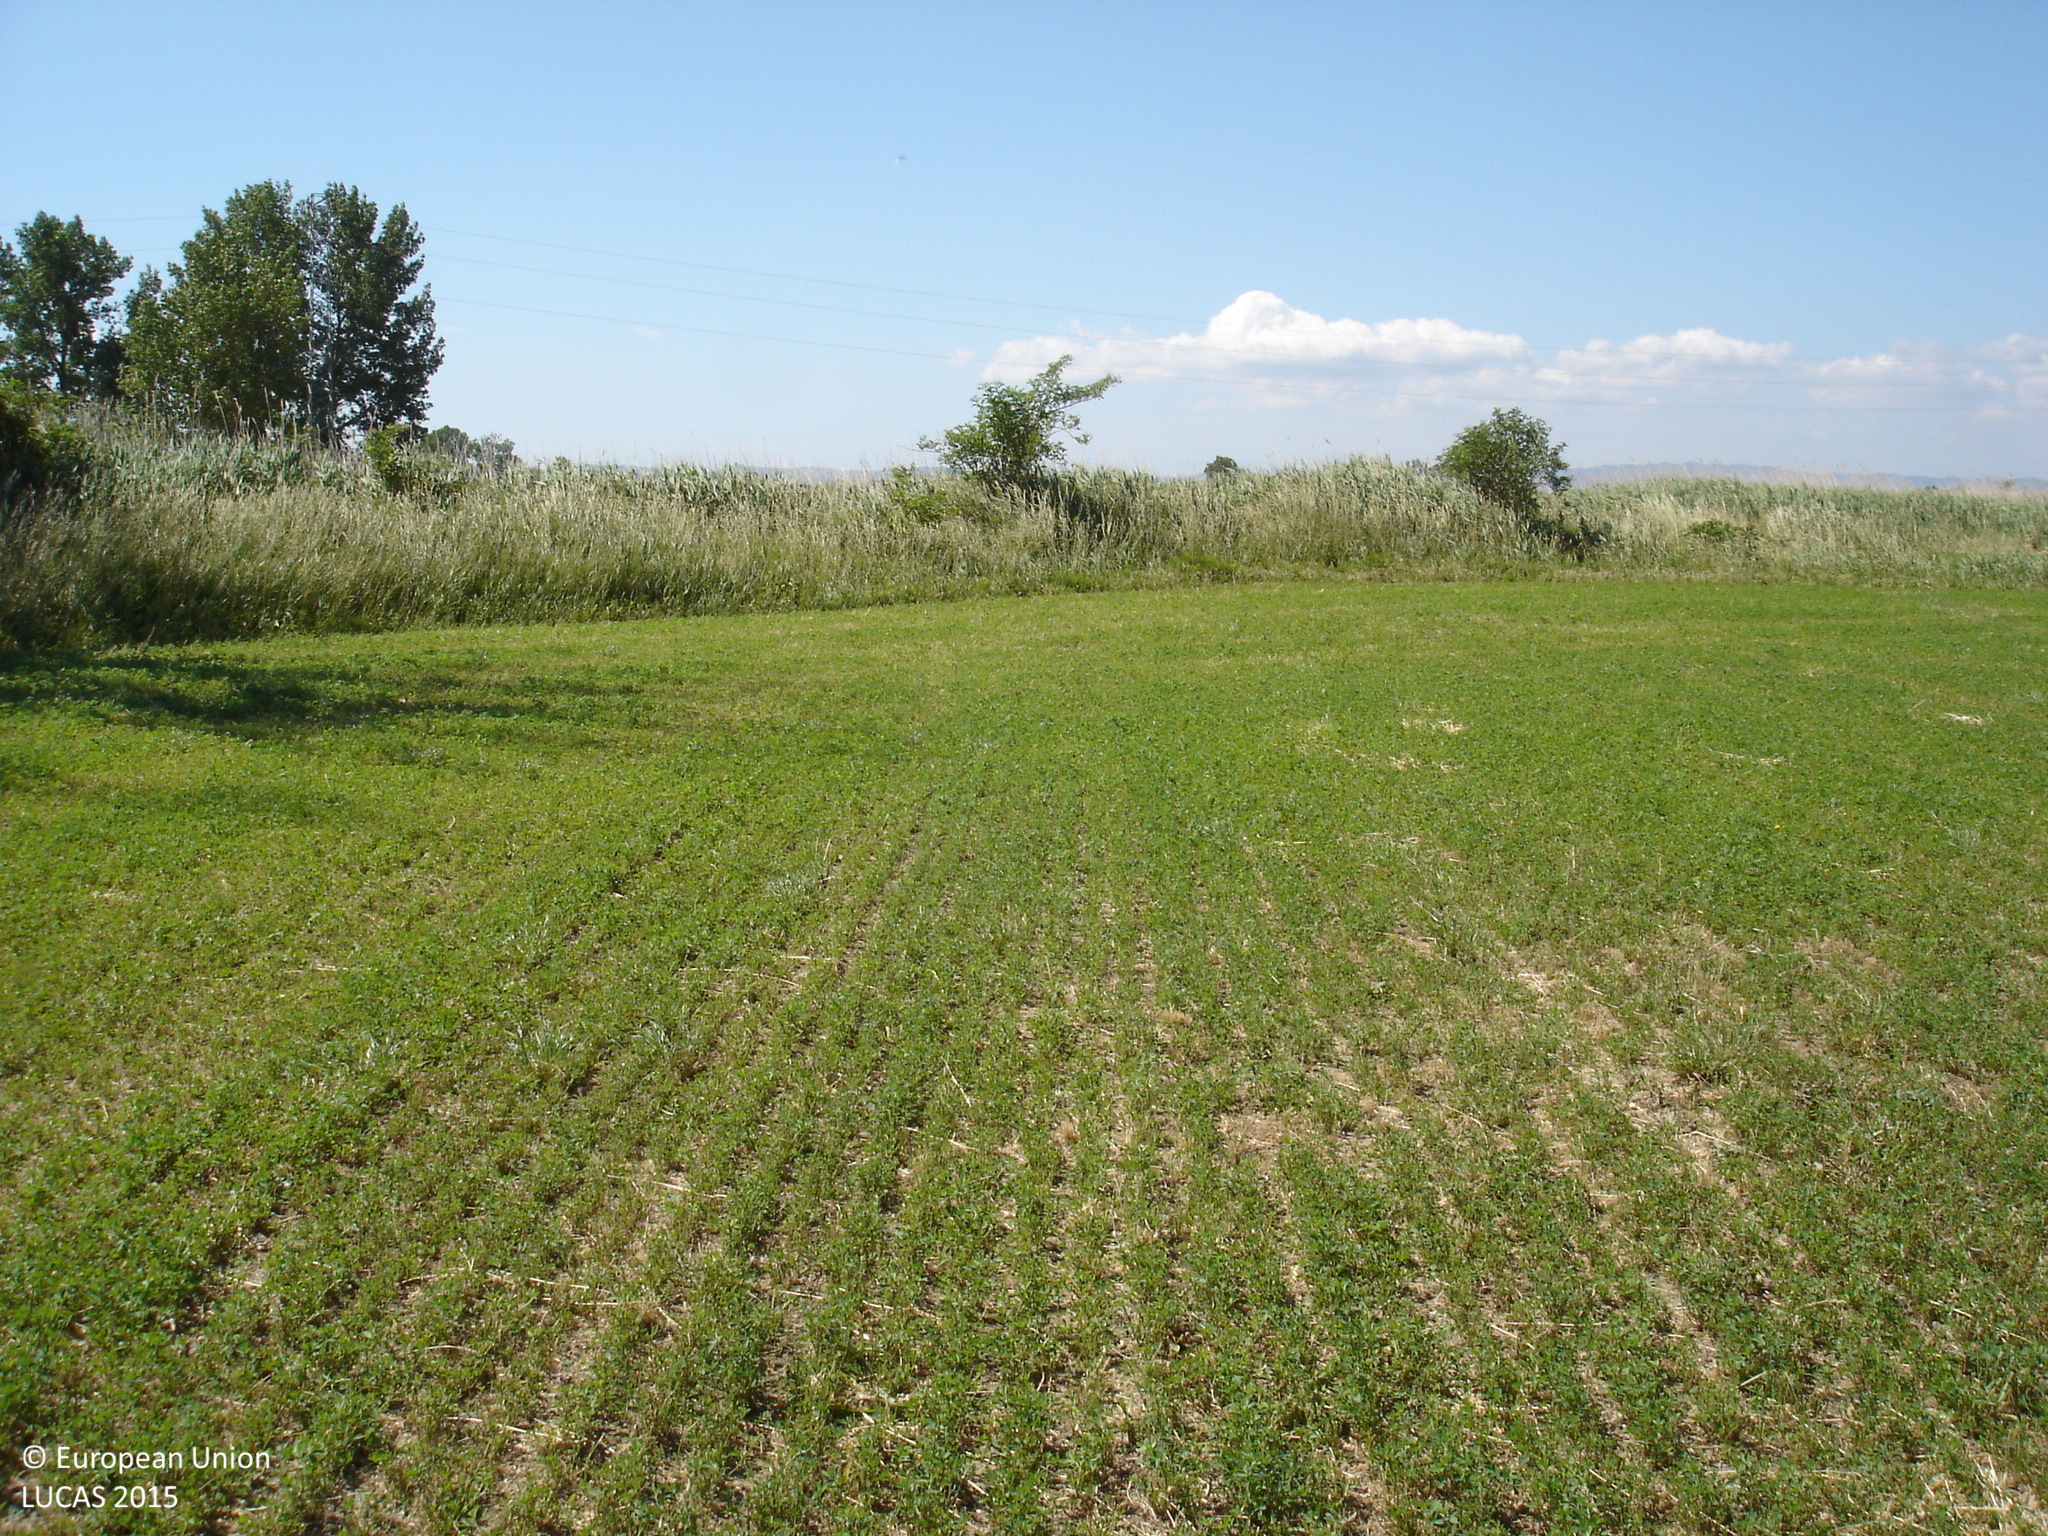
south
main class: Cropland
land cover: Lucerne
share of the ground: > 75 %
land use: Agriculture (excluding fallow land and kitchen gardens)
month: May
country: ES
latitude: 42.0735
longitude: 3.0897
